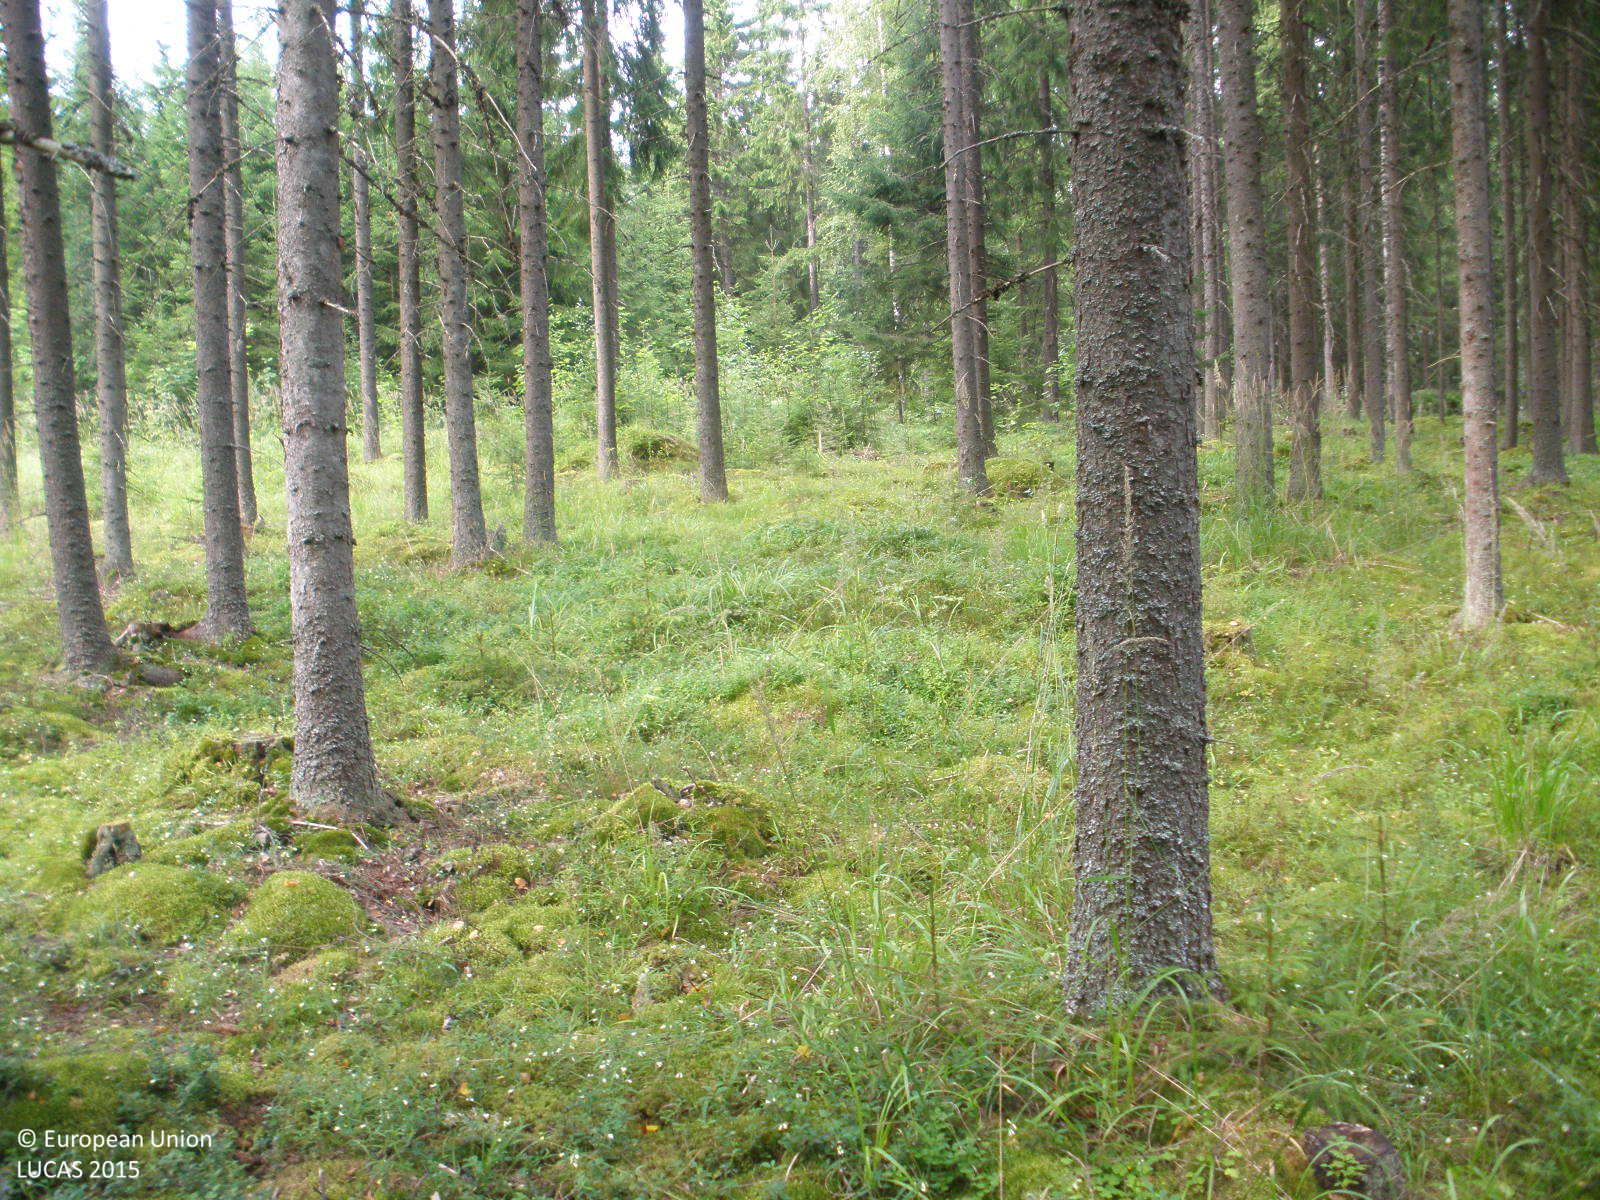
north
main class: Woodland
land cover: Spruce dominated coniferous woodland
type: boreal forest
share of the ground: > 75 %
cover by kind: coniferous forest trees 80 %, herbaceous plants 10 %, broadleaved forest trees 5 %, lichens and mosses 5 %
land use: Forestry
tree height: > 5 m
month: August
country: FI
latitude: 60.7365
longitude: 24.4259
